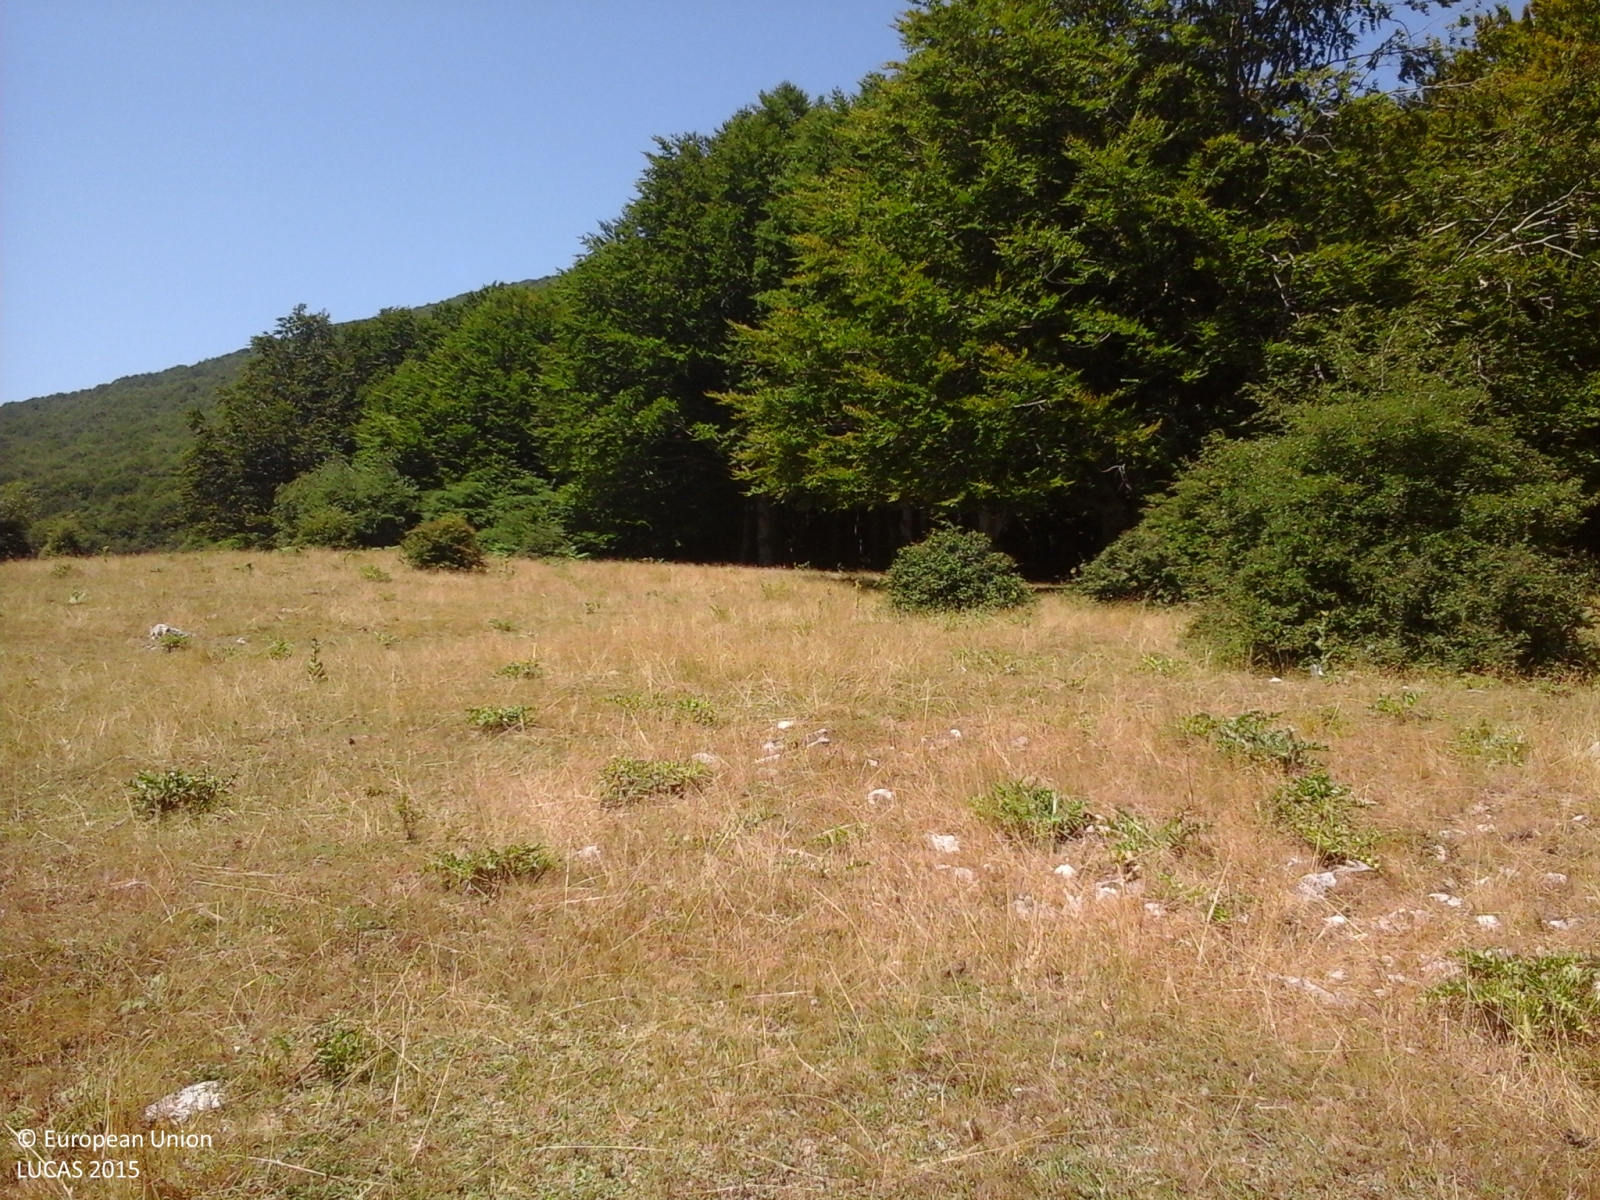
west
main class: Grassland
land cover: Grassland without tree/shrub cover
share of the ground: > 75 %
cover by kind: herbaceous plants 100 %
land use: Agriculture (excluding fallow land and kitchen gardens)
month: July
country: IT
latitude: 40.7867
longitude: 15.1109
